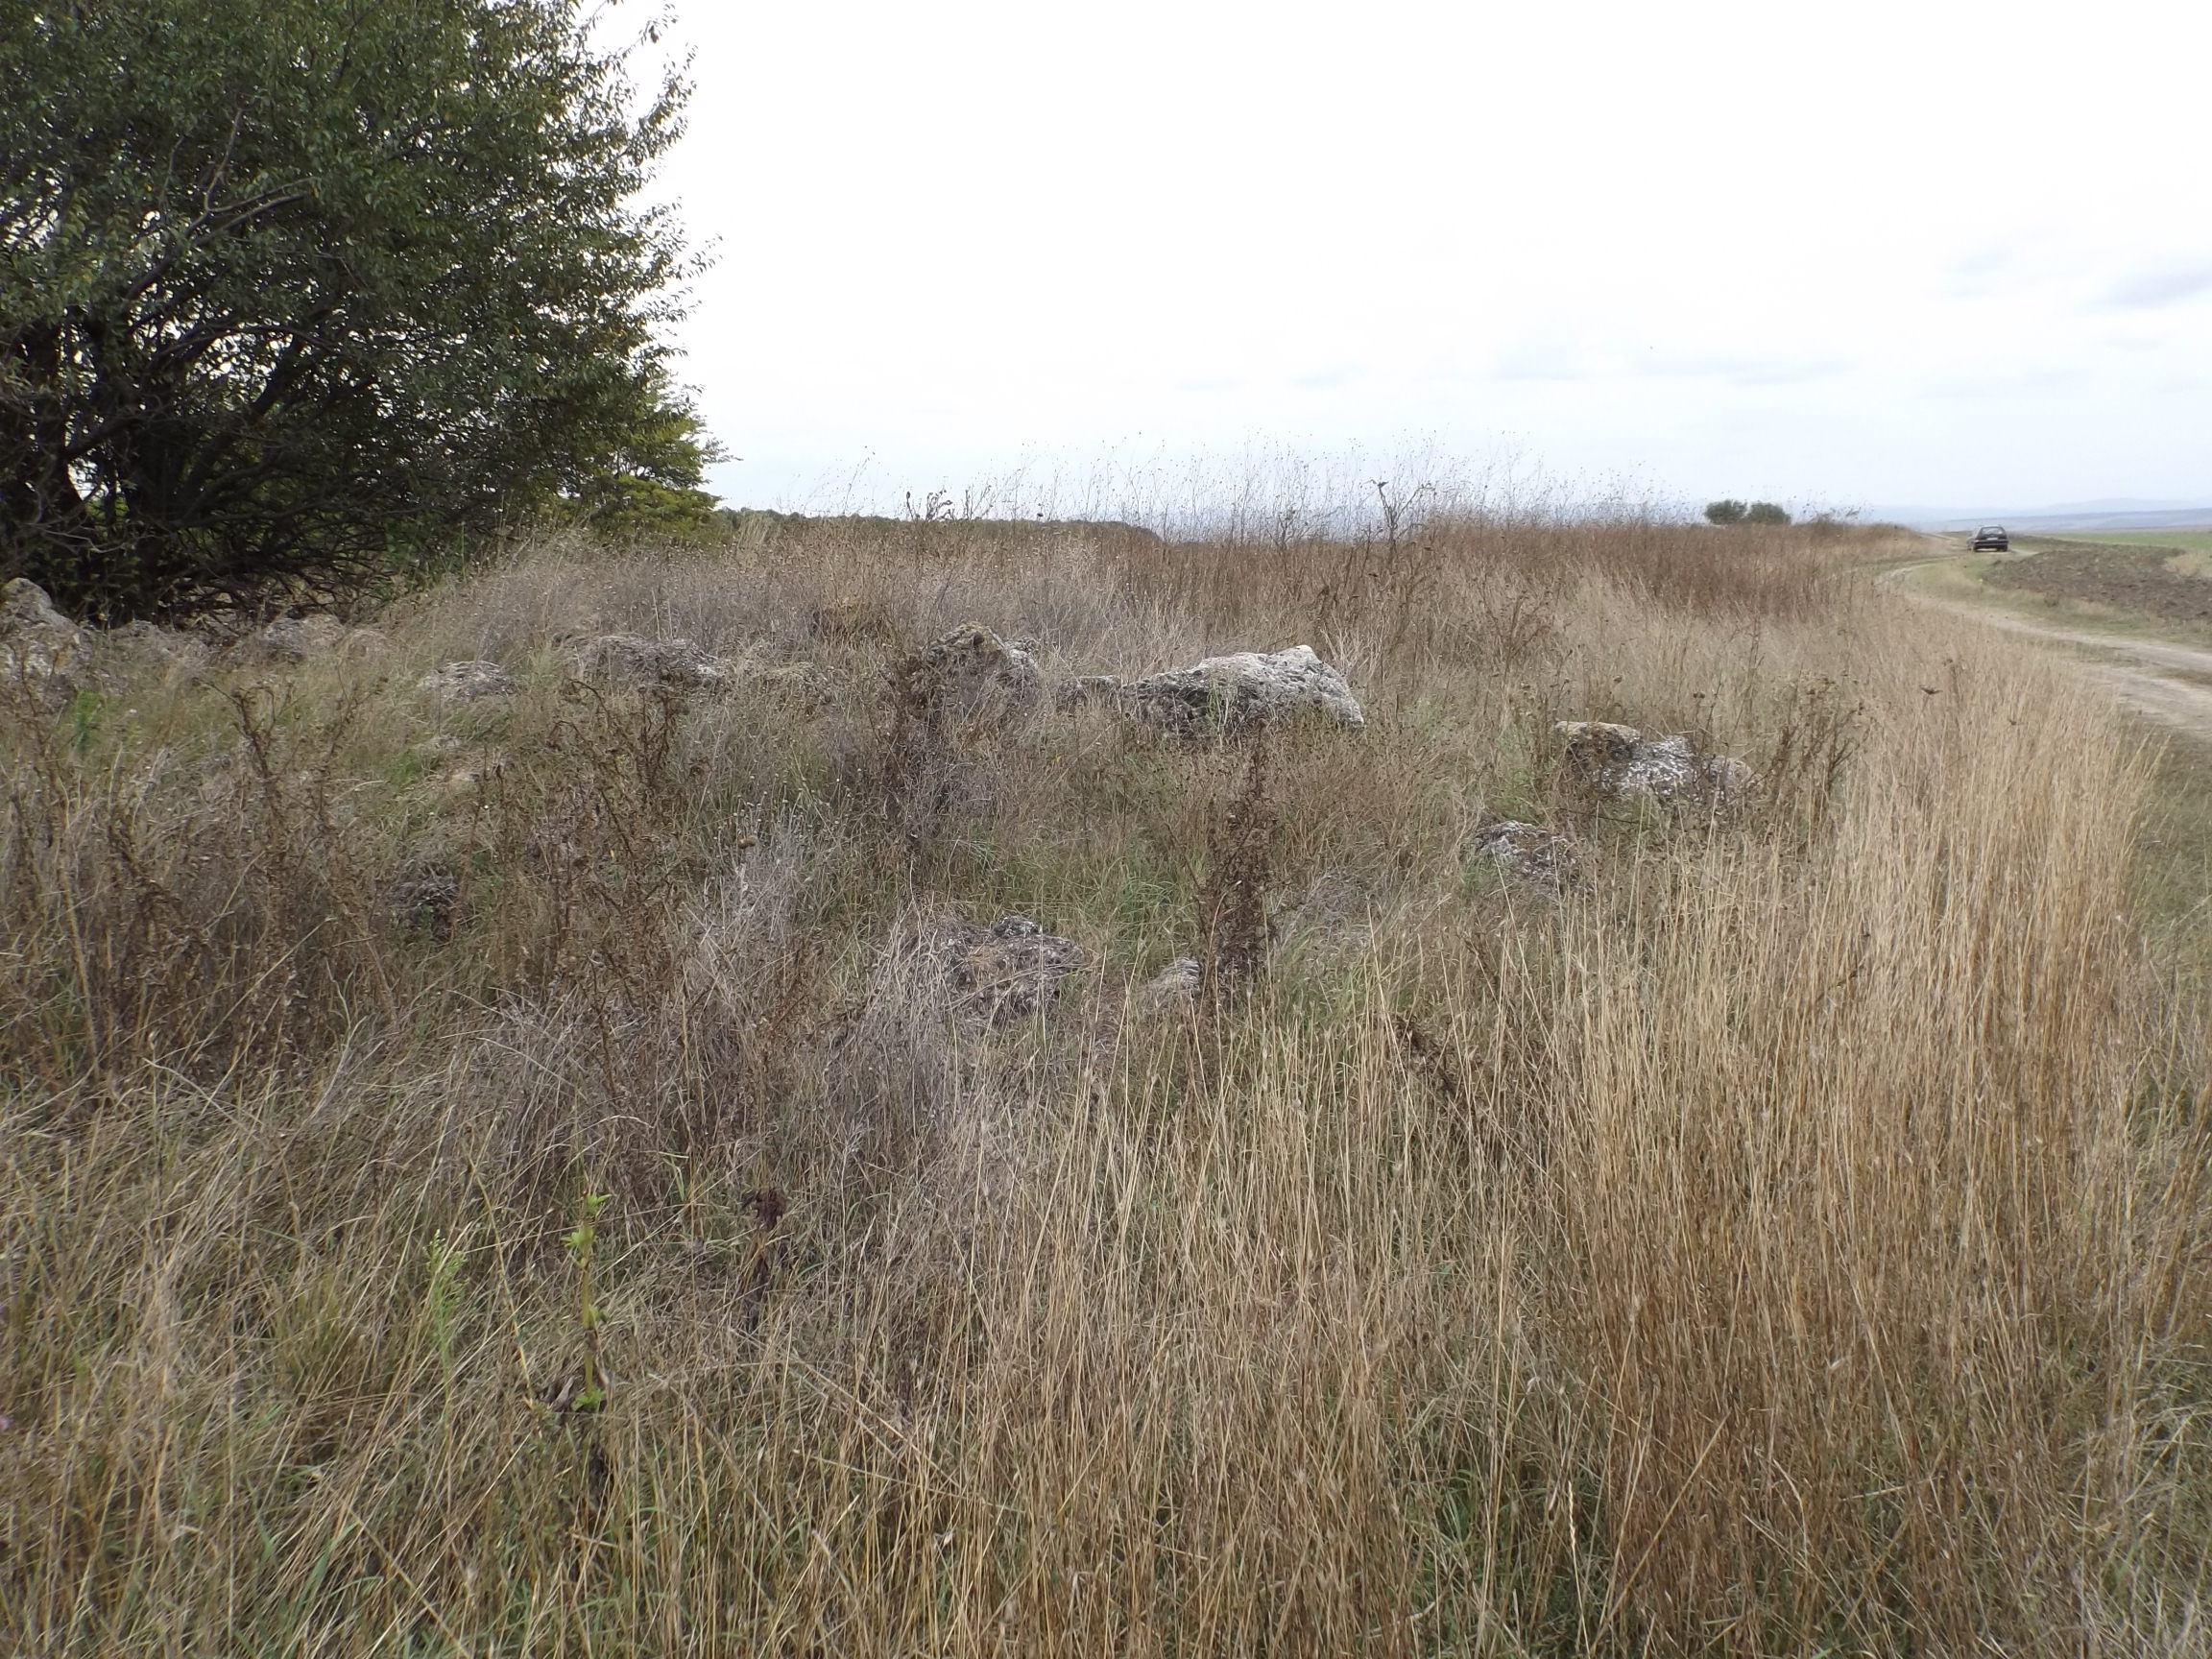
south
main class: Grassland
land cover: Spontaneously vegetated surfaces
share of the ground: > 75 %
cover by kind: herbaceous plants 95 %, shrubs 5 %
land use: Semi-natural and natural areas not in use
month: September
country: BG
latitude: 43.1706
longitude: 27.5587
